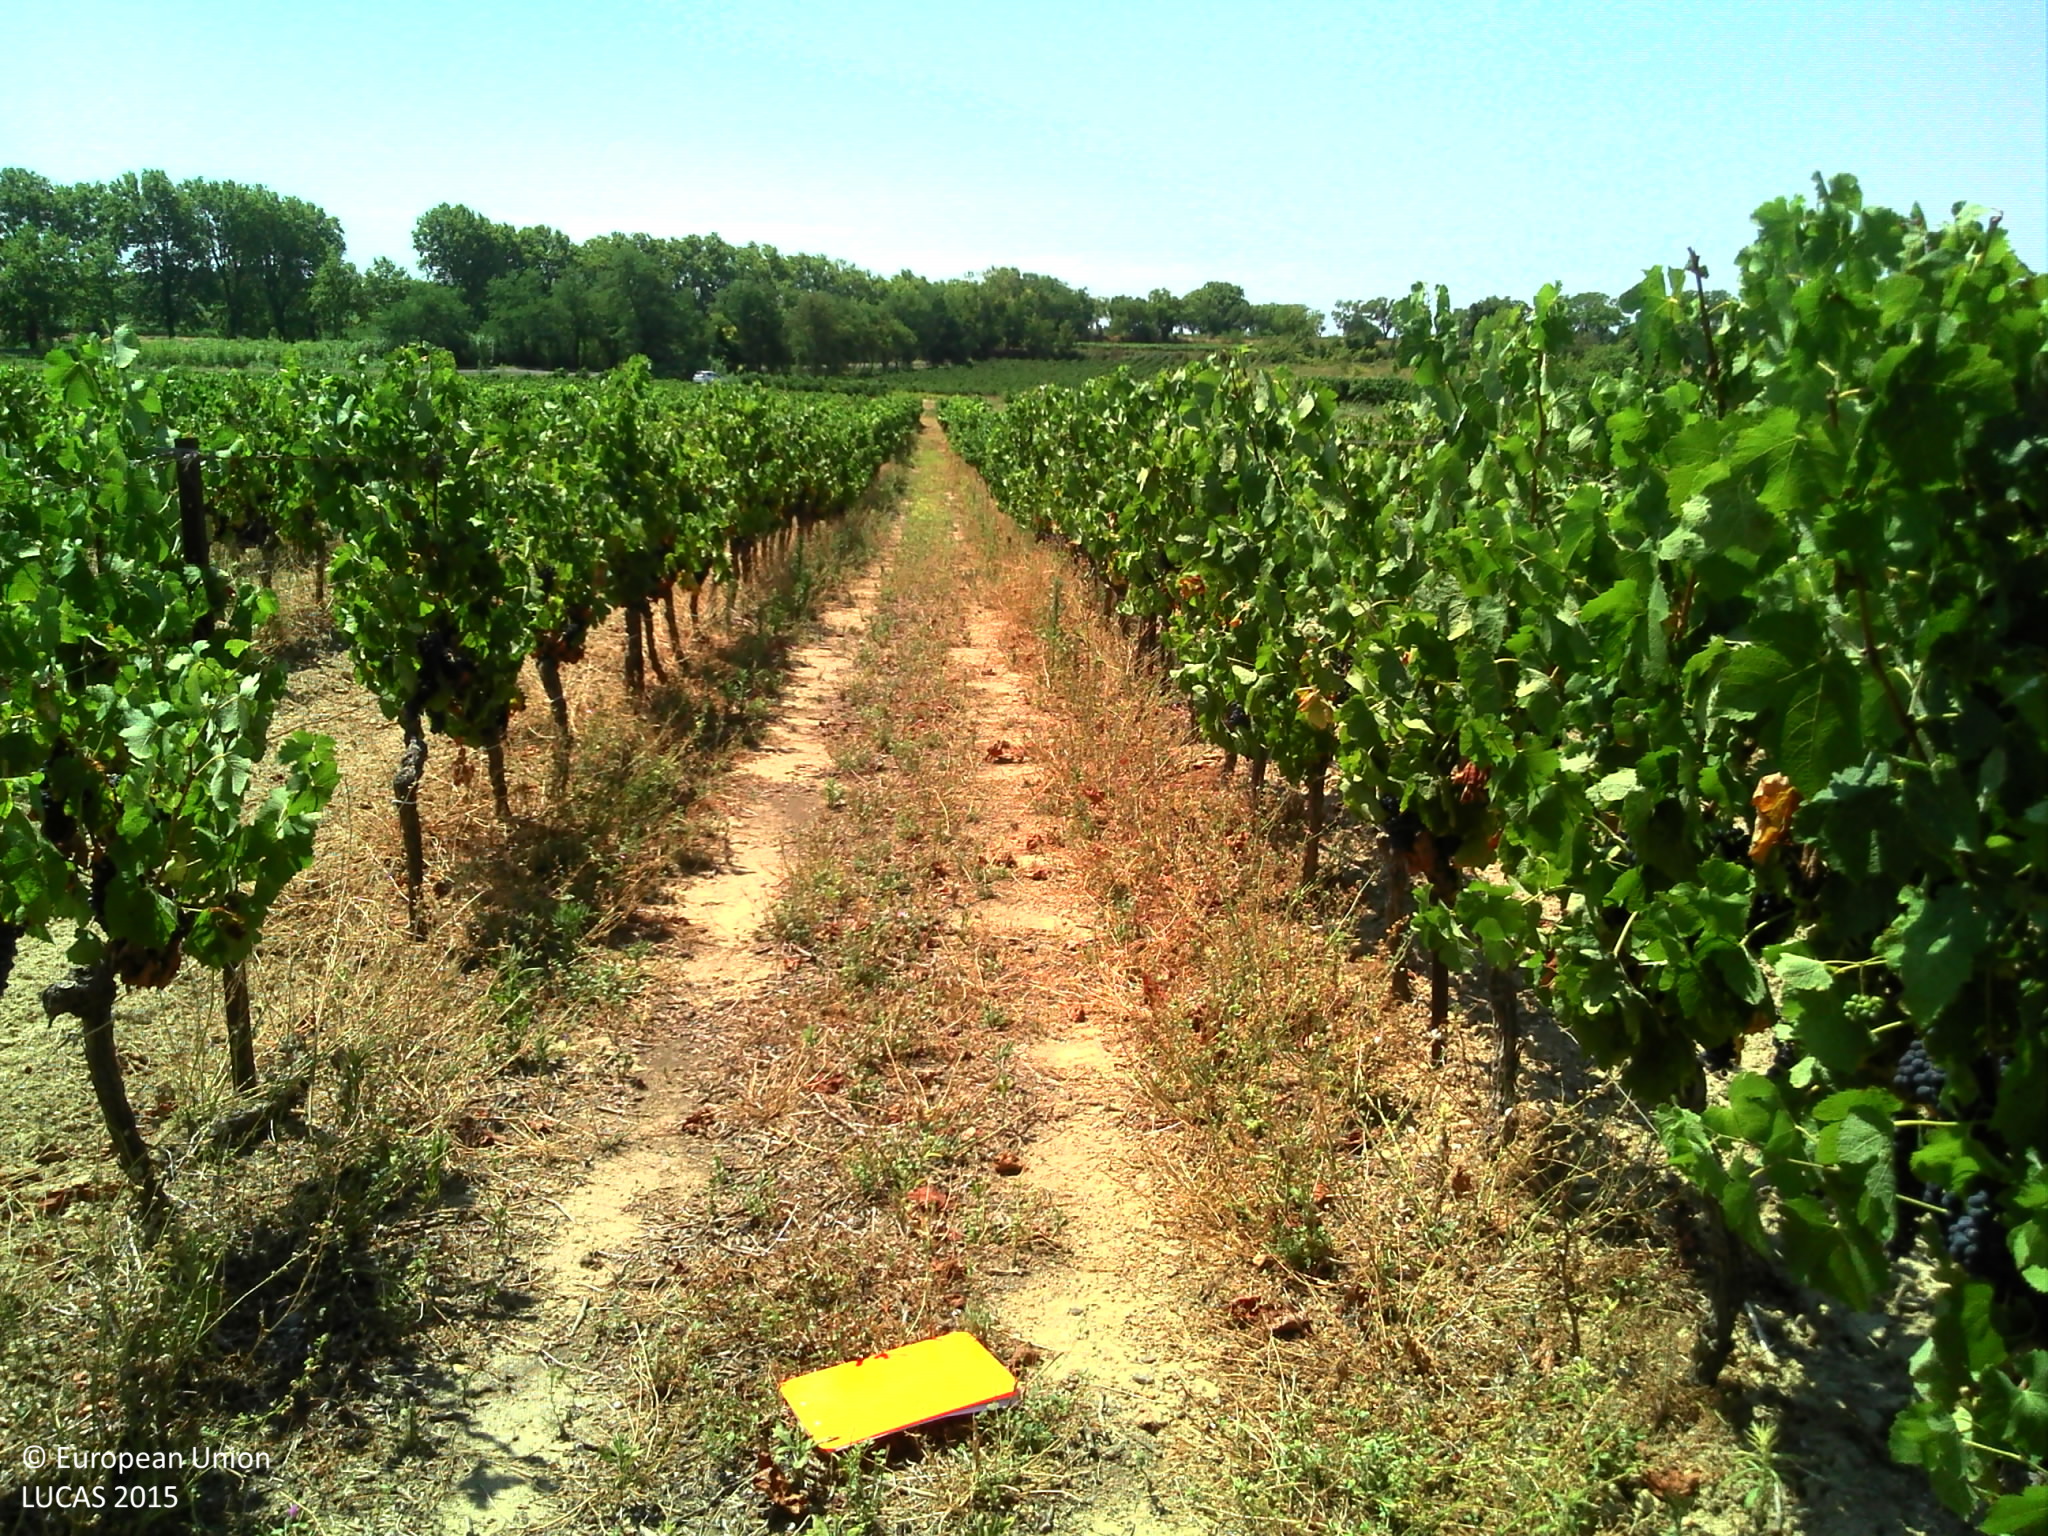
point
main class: Cropland
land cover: Vineyards
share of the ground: 10 - 25 %
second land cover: Other bare soil
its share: > 75 %
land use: Agriculture (excluding fallow land and kitchen gardens)
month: August
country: FR
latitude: 43.4330
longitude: 3.3753
